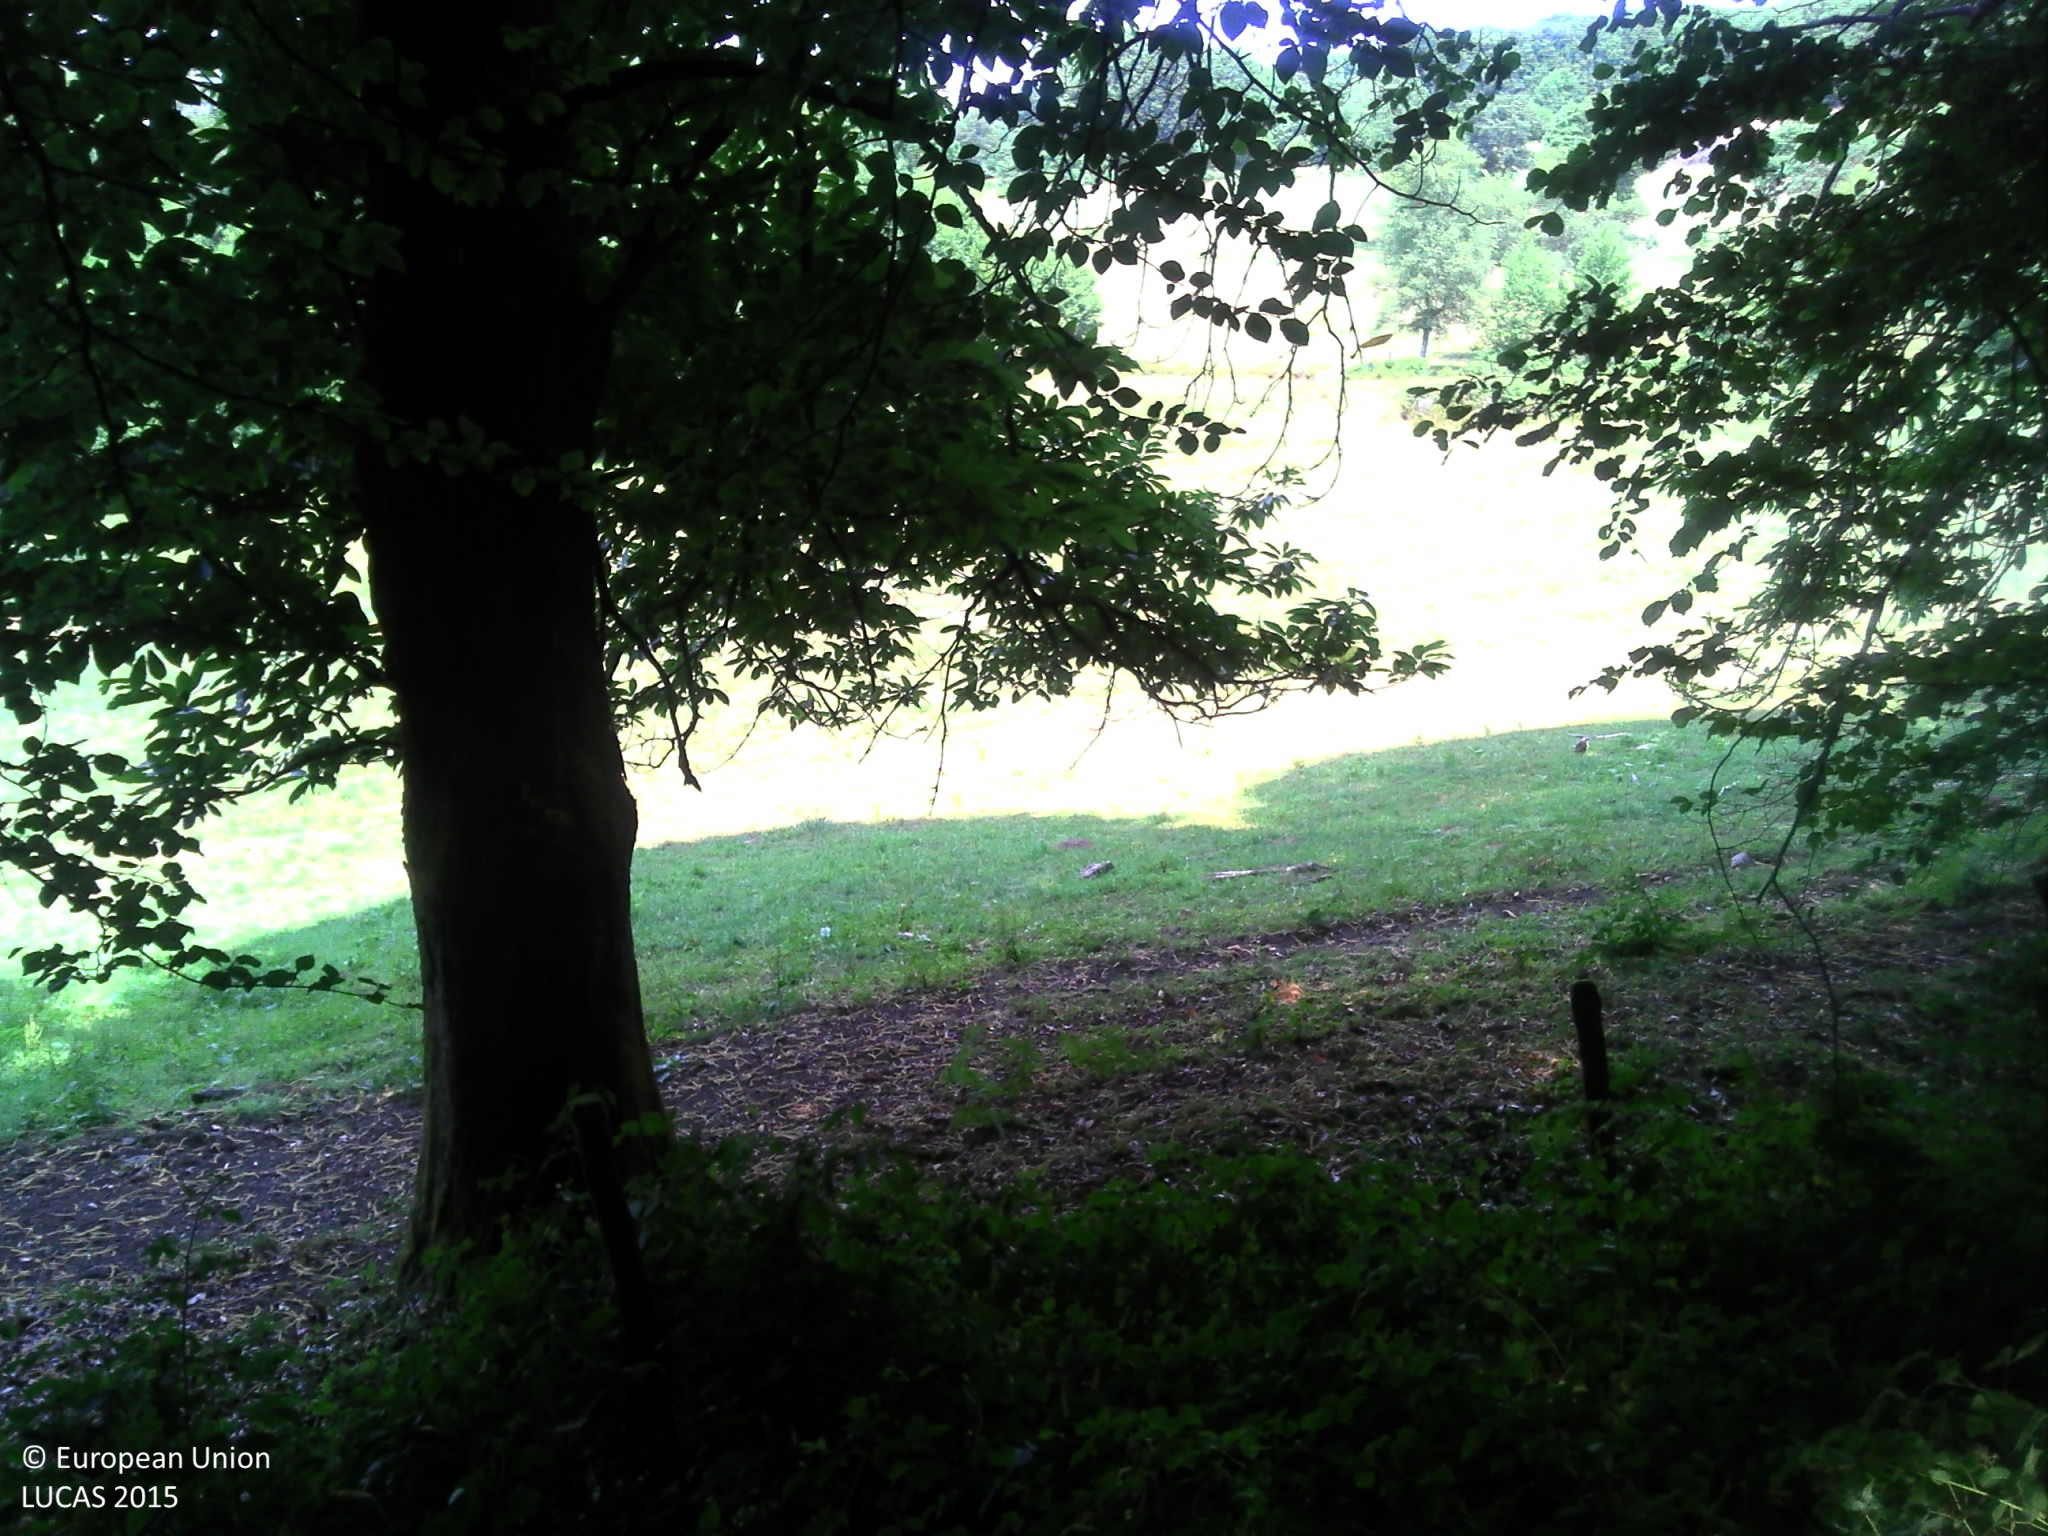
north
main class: Woodland
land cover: Spruce dominated mixed woodland
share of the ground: > 75 %
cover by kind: coniferous forest trees 45 %, broadleaved forest trees 40 %, shrubs 5 %, herbaceous plants 5 %, lichens and mosses 5 %
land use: Forestry
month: July
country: FR
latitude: 45.9457
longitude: 1.8021
